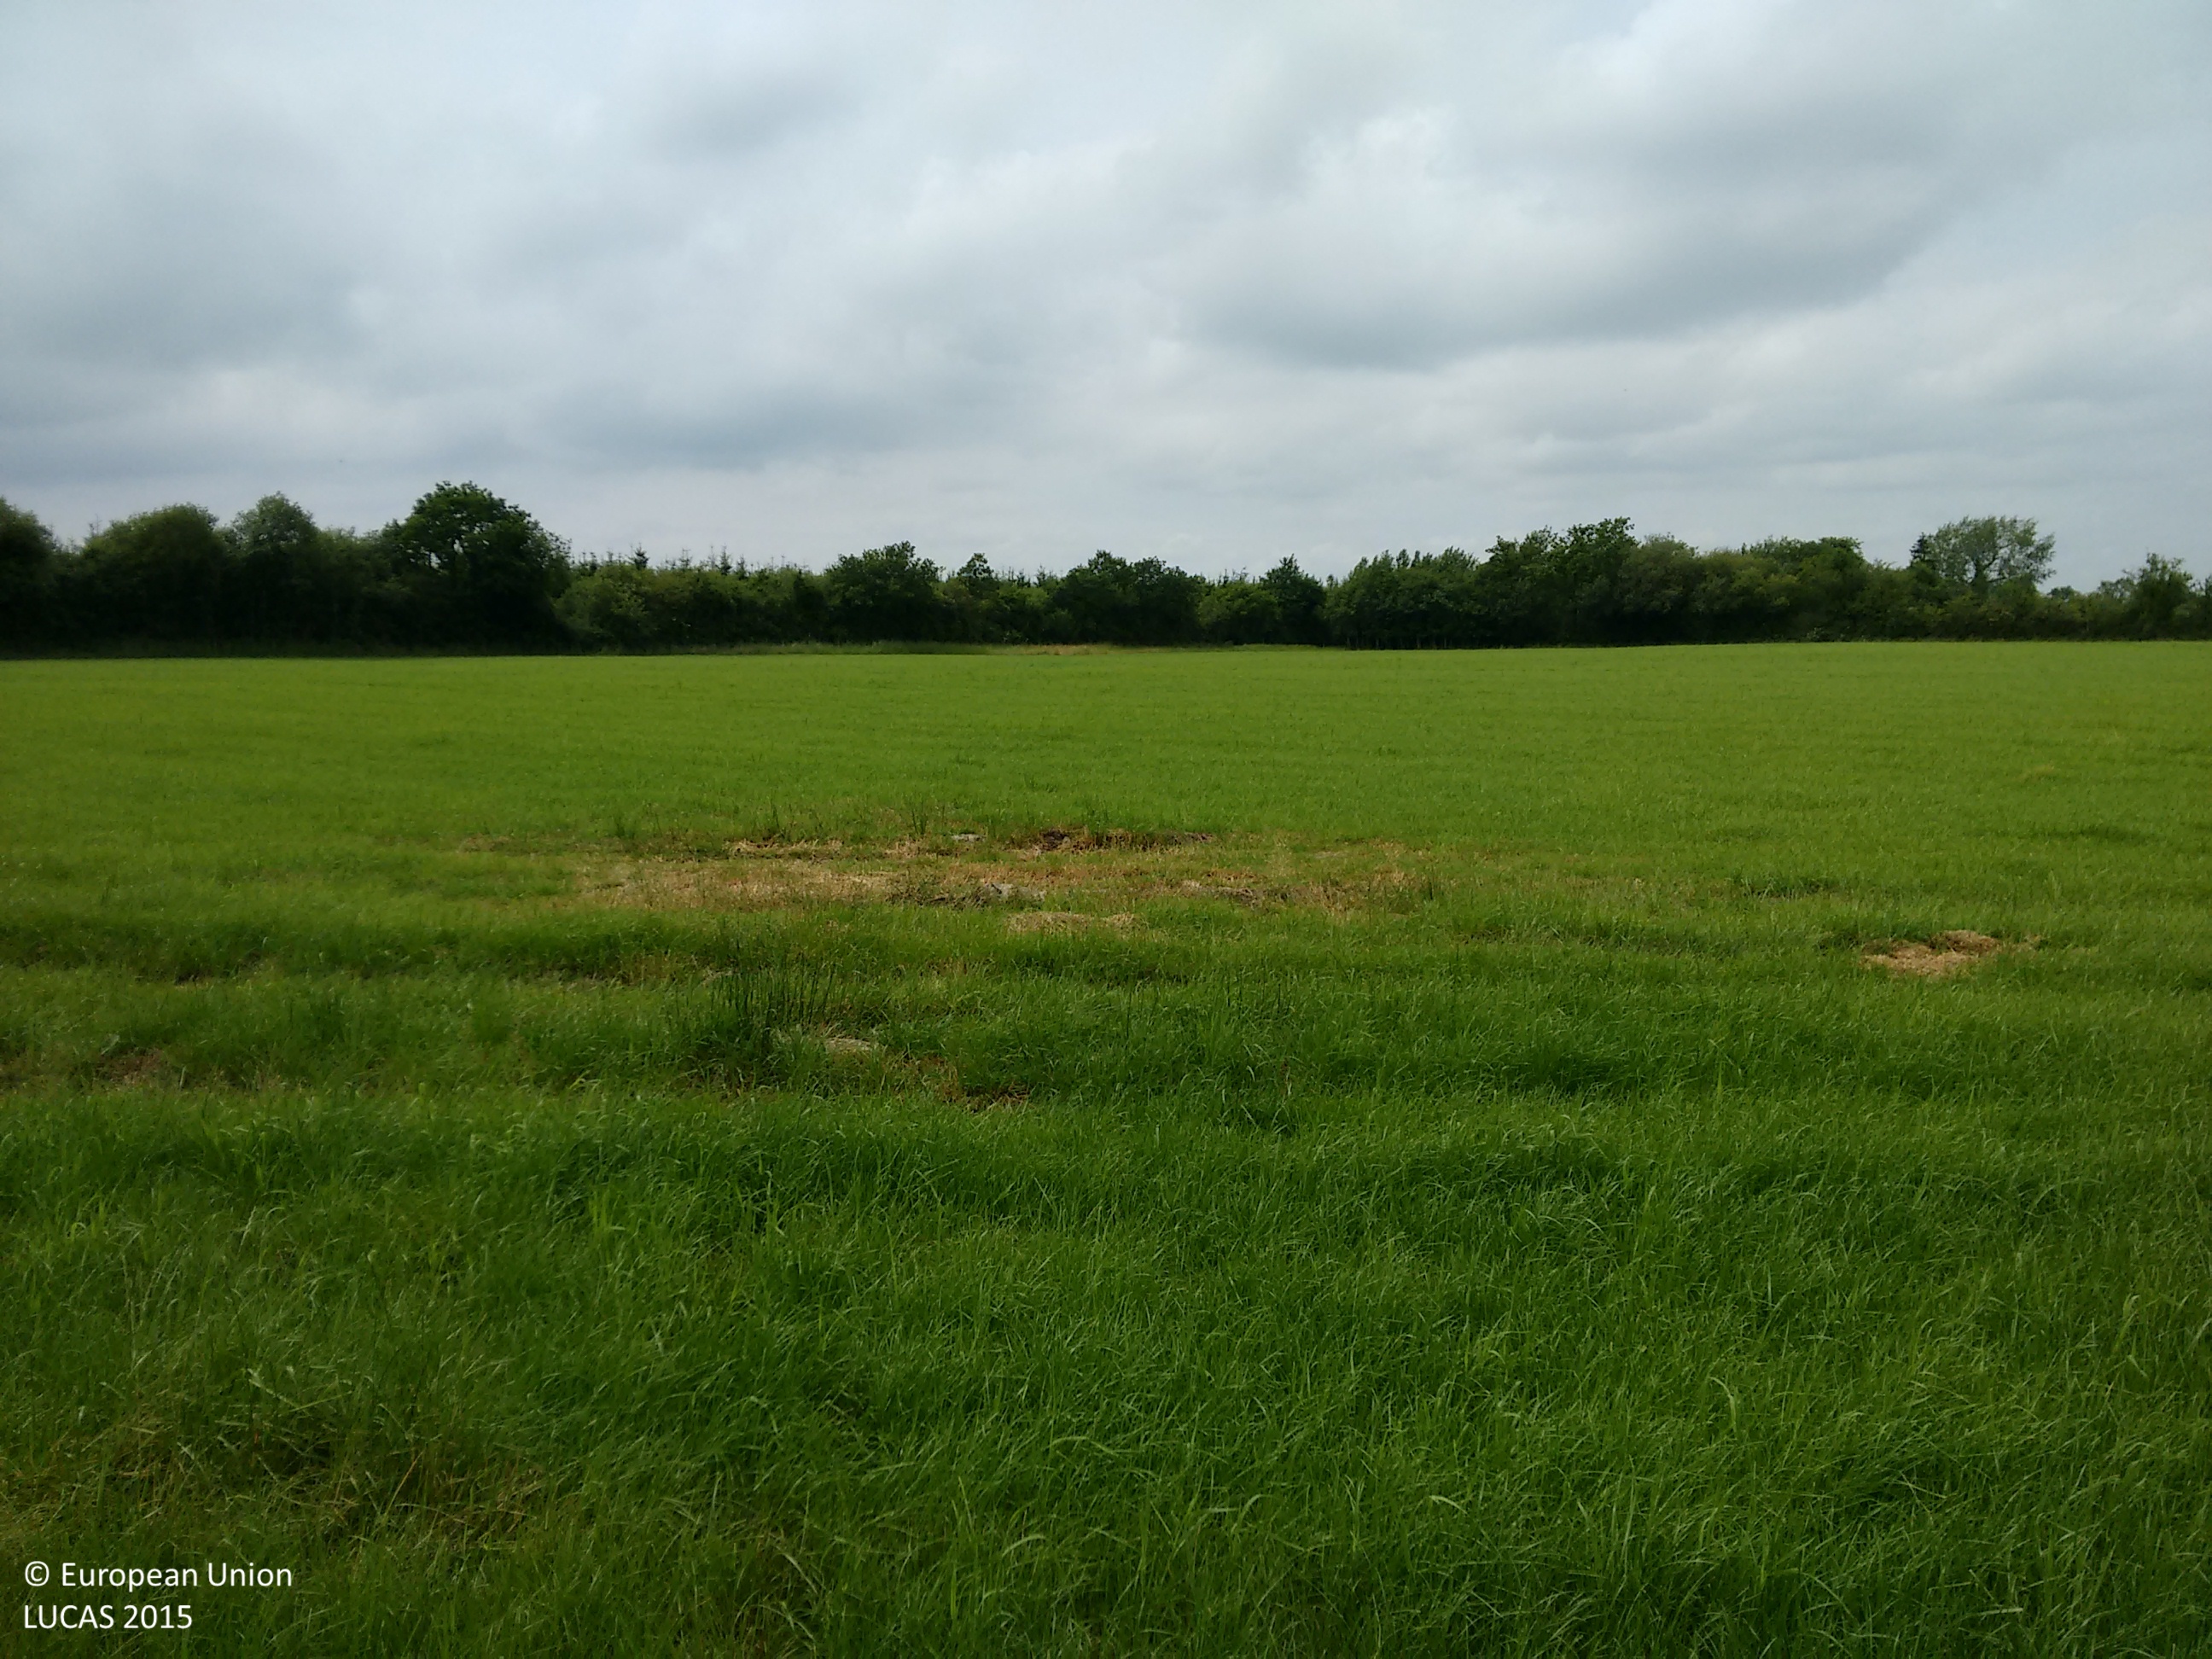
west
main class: Grassland
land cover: Grassland without tree/shrub cover
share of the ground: > 75 %
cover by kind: herbaceous plants 100 %
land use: Agriculture (excluding fallow land and kitchen gardens)
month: July
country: IE
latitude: 52.4912
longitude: -7.4325
